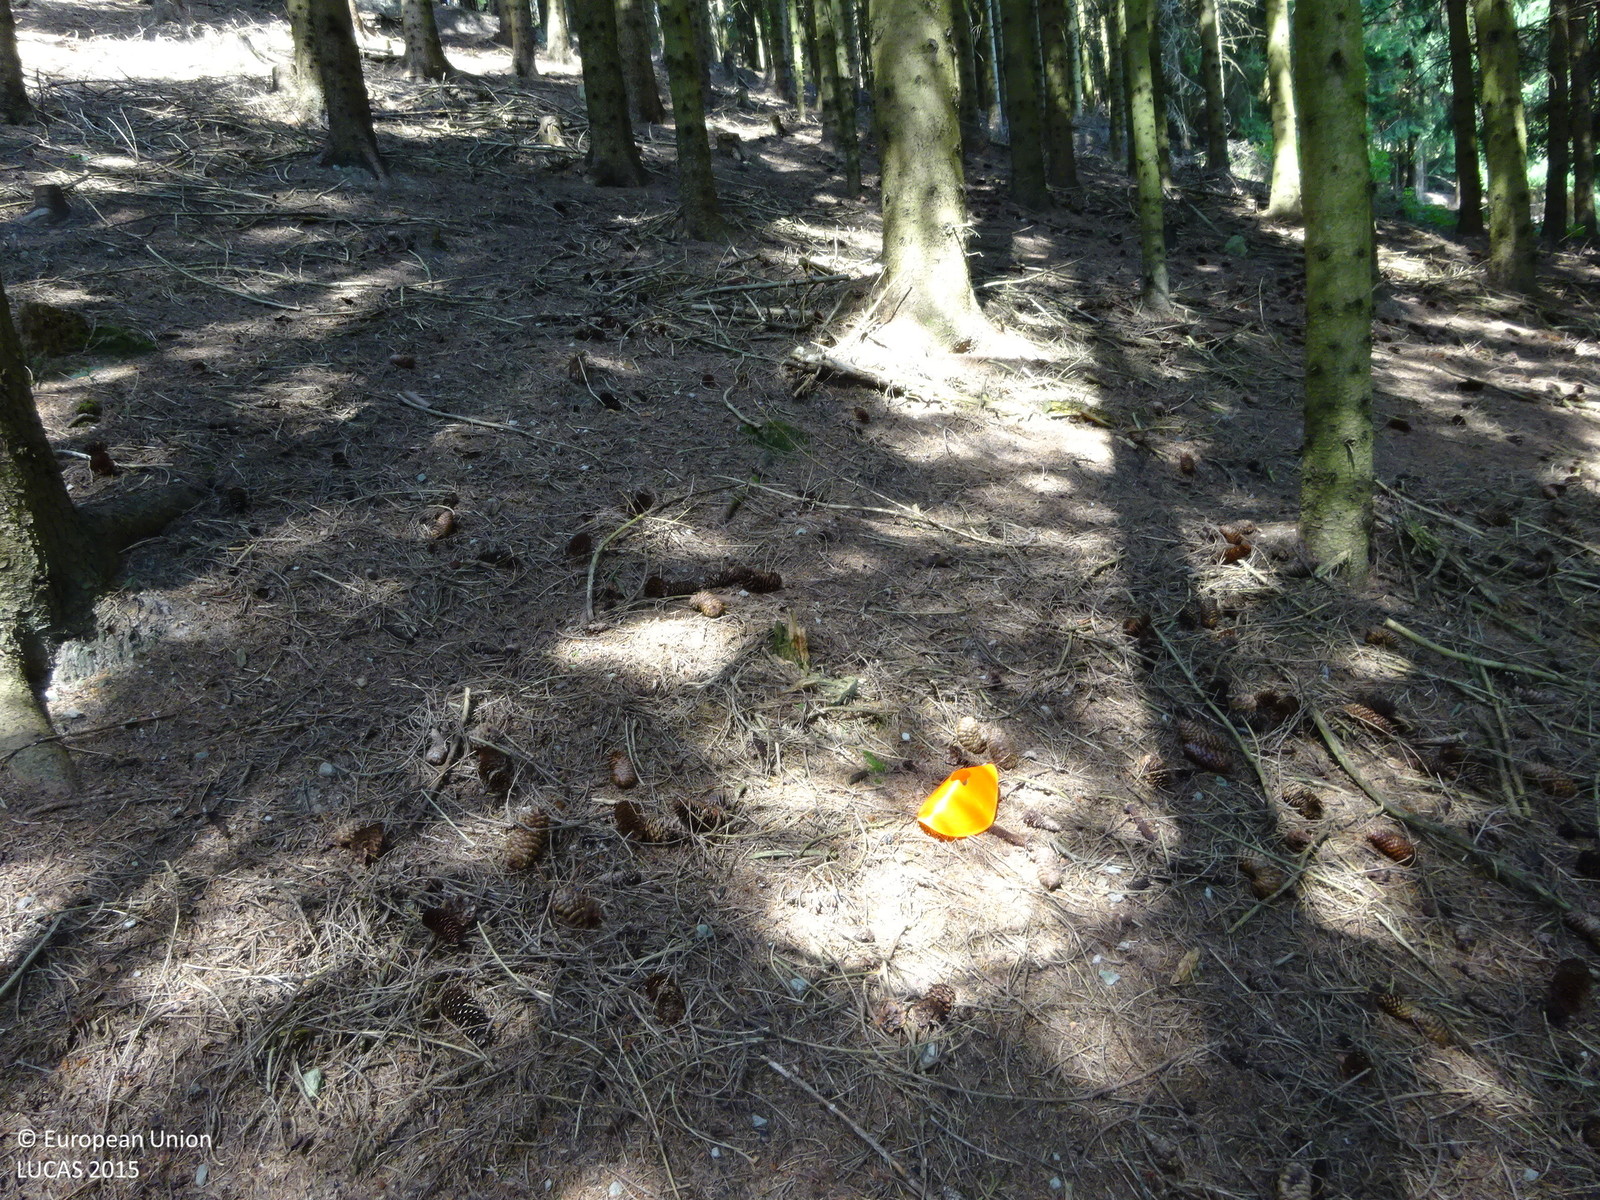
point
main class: Woodland
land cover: Spruce dominated coniferous woodland
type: alpine coniferous forest
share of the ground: > 75 %
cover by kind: coniferous forest trees 100 %
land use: Forestry
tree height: > 5 m
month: August
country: AT
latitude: 47.4589
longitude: 15.7717
